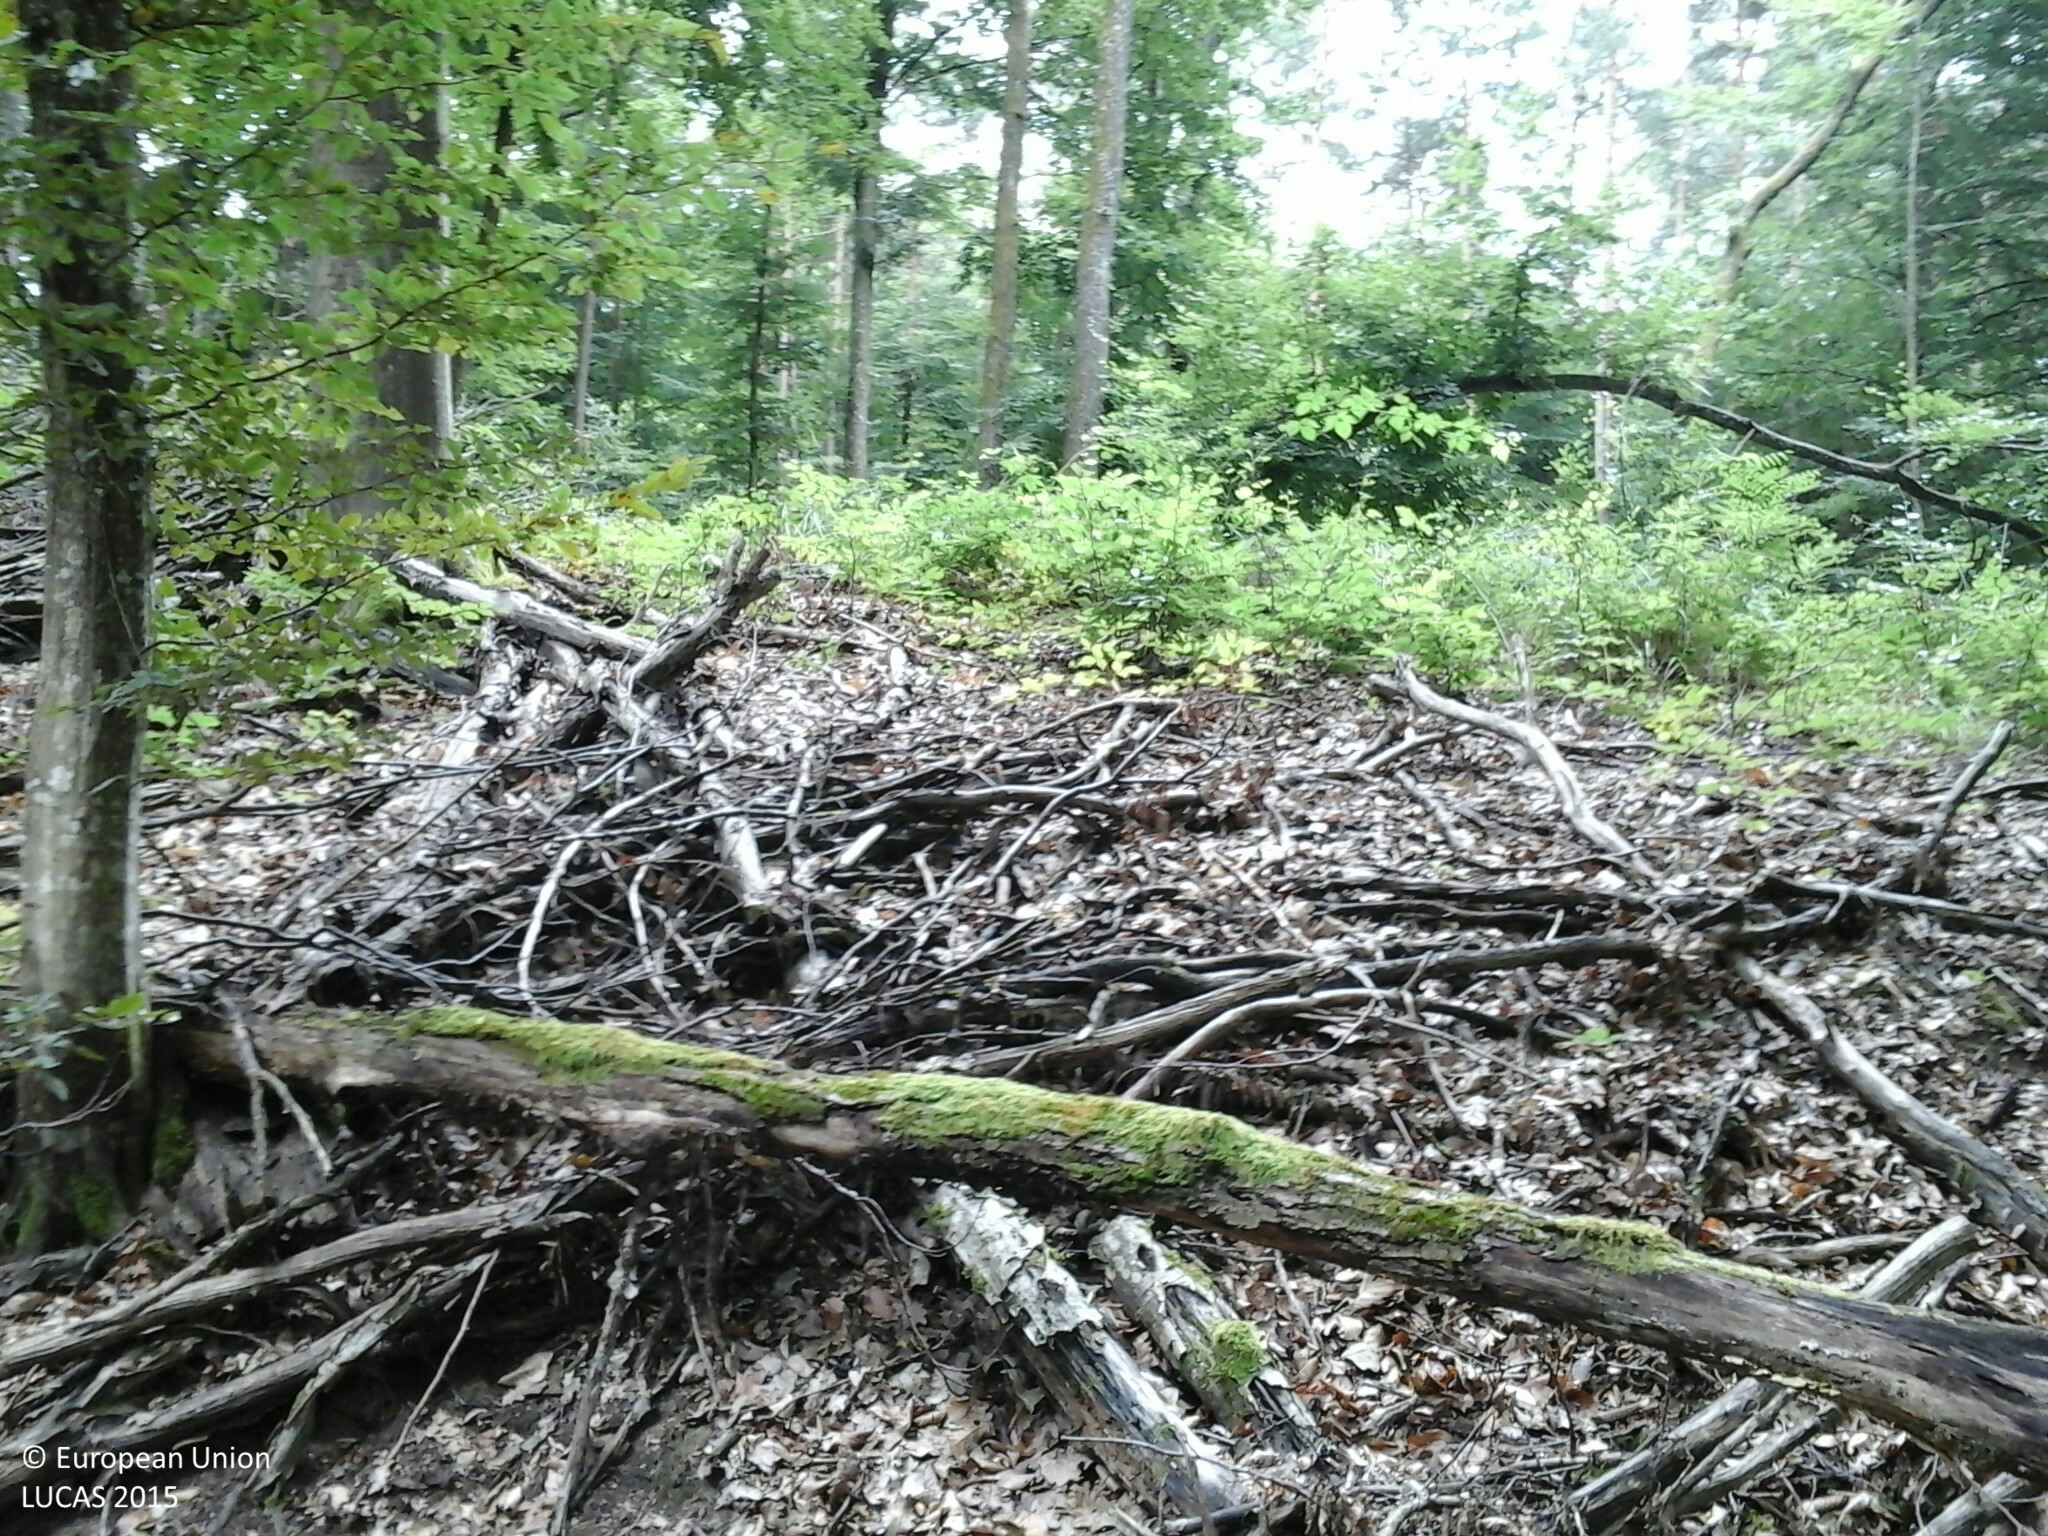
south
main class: Woodland
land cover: Broadleaved woodland
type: beech forest
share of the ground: > 75 %
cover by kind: broadleaved forest trees 85 %, shrubs 10 %, herbaceous plants 5 %
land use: Forestry
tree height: > 5 m
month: July
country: HU
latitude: 46.7733
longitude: 16.4055
